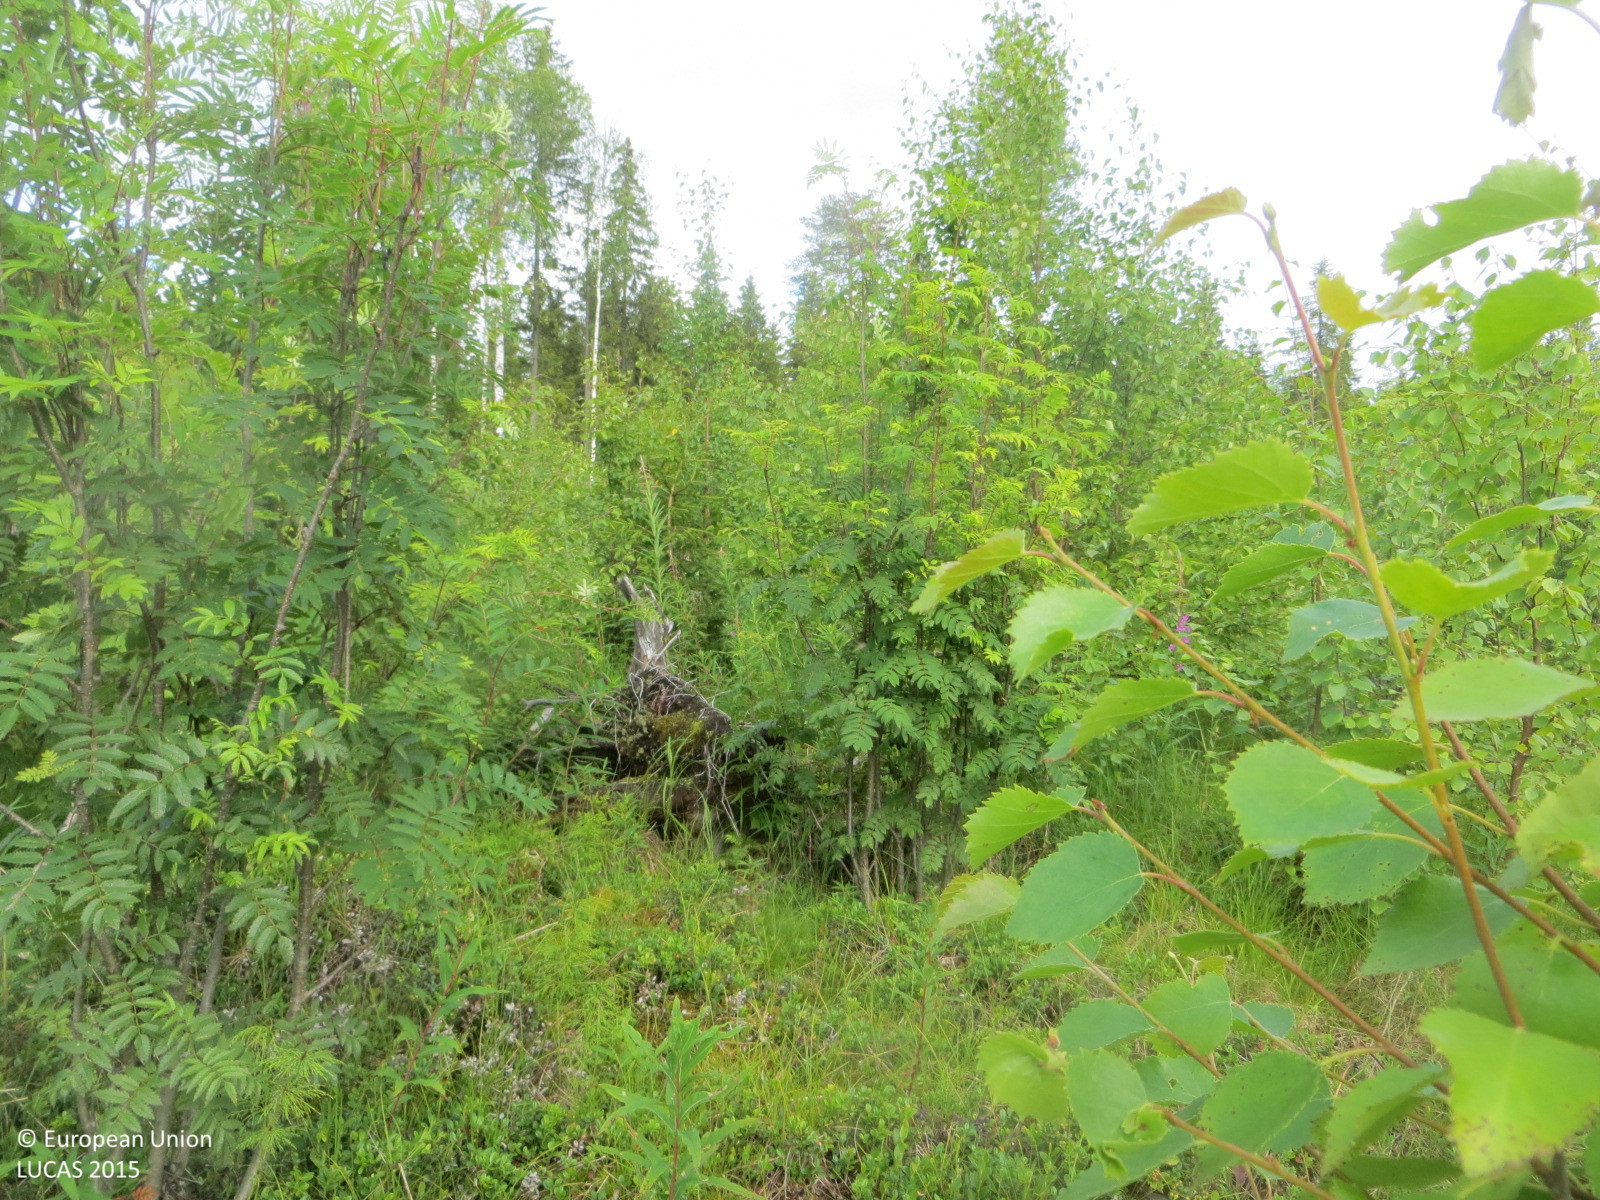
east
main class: Woodland
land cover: Broadleaved woodland
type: boreal forest
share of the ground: > 75 %
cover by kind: broadleaved forest trees 75 %, herbaceous plants 15 %, shrubs 10 %
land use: Forestry
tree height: < 5 m
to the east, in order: Broadleaved woodland; Ditches and canals; Broadleaved woodland; Ditches and canals; Broadleaved woodland; Ditches and canals; Broadleaved woodland; Tracks; Spruce dominated coniferous woodland; Electric lines; Spruce dominated coniferous woodland; Tracks; Spruce dominated coniferous woodland; Ditches and canals; Abandoned hedges; Tracks; Abandoned hedges; Ditches and canals; Spruce dominated mixed woodland
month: July
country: FI
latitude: 65.9955
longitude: 24.3008
